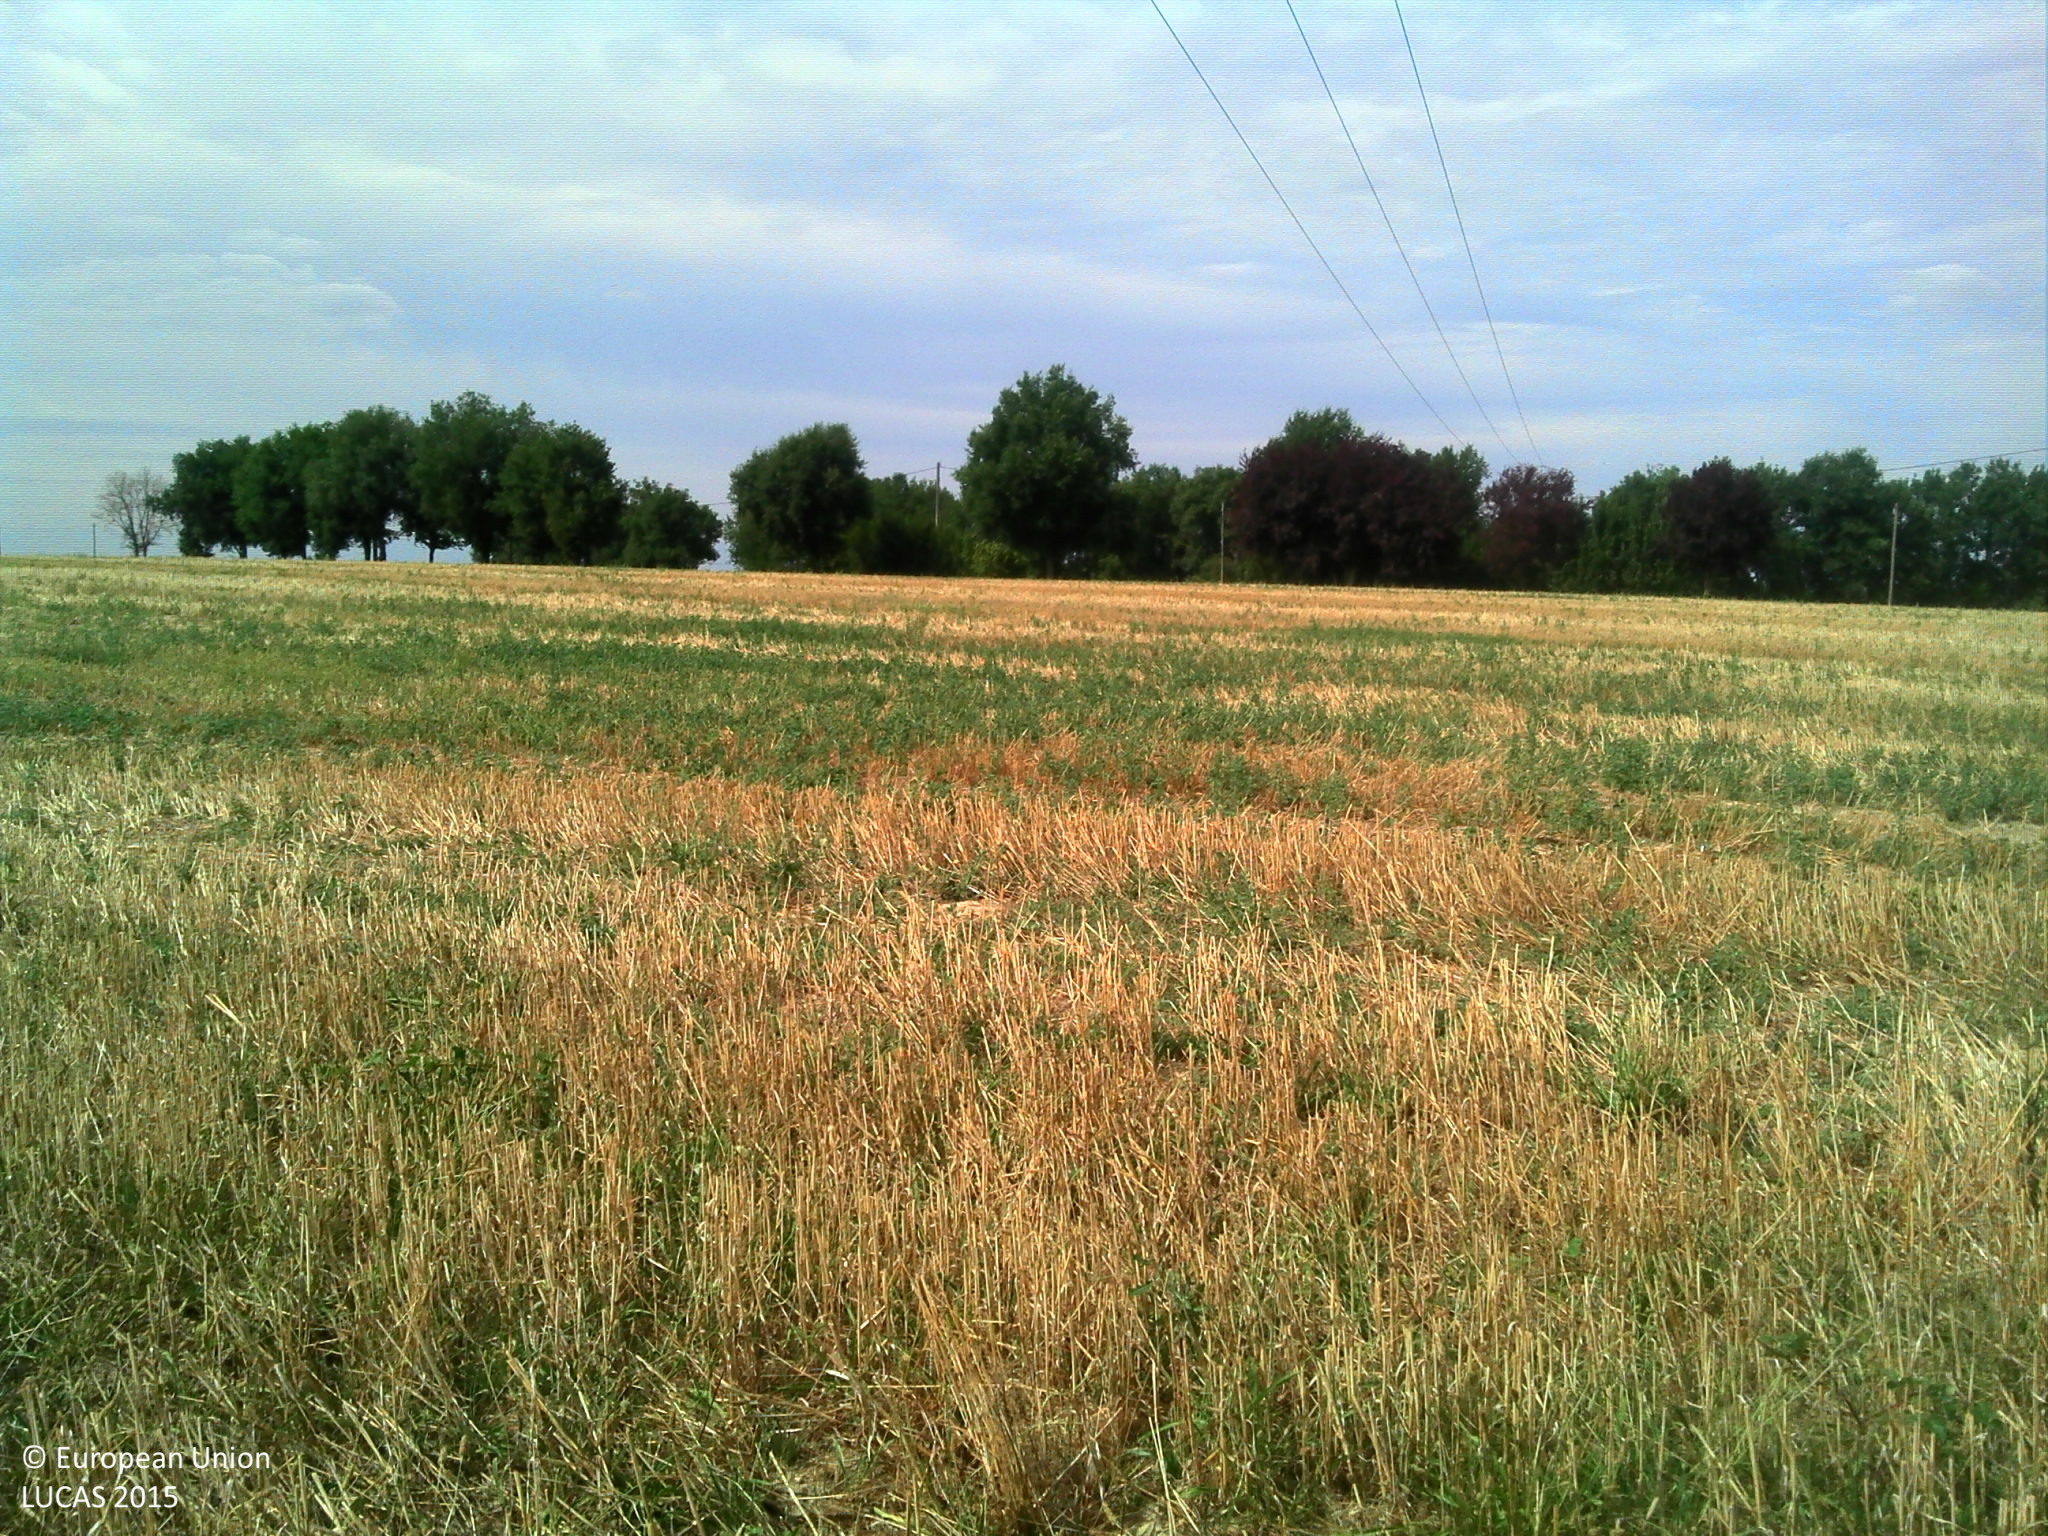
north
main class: Cropland
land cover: Common wheat
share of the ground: > 75 %
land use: Agriculture (excluding fallow land and kitchen gardens)
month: July
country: FR
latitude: 44.1124
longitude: 0.6872
